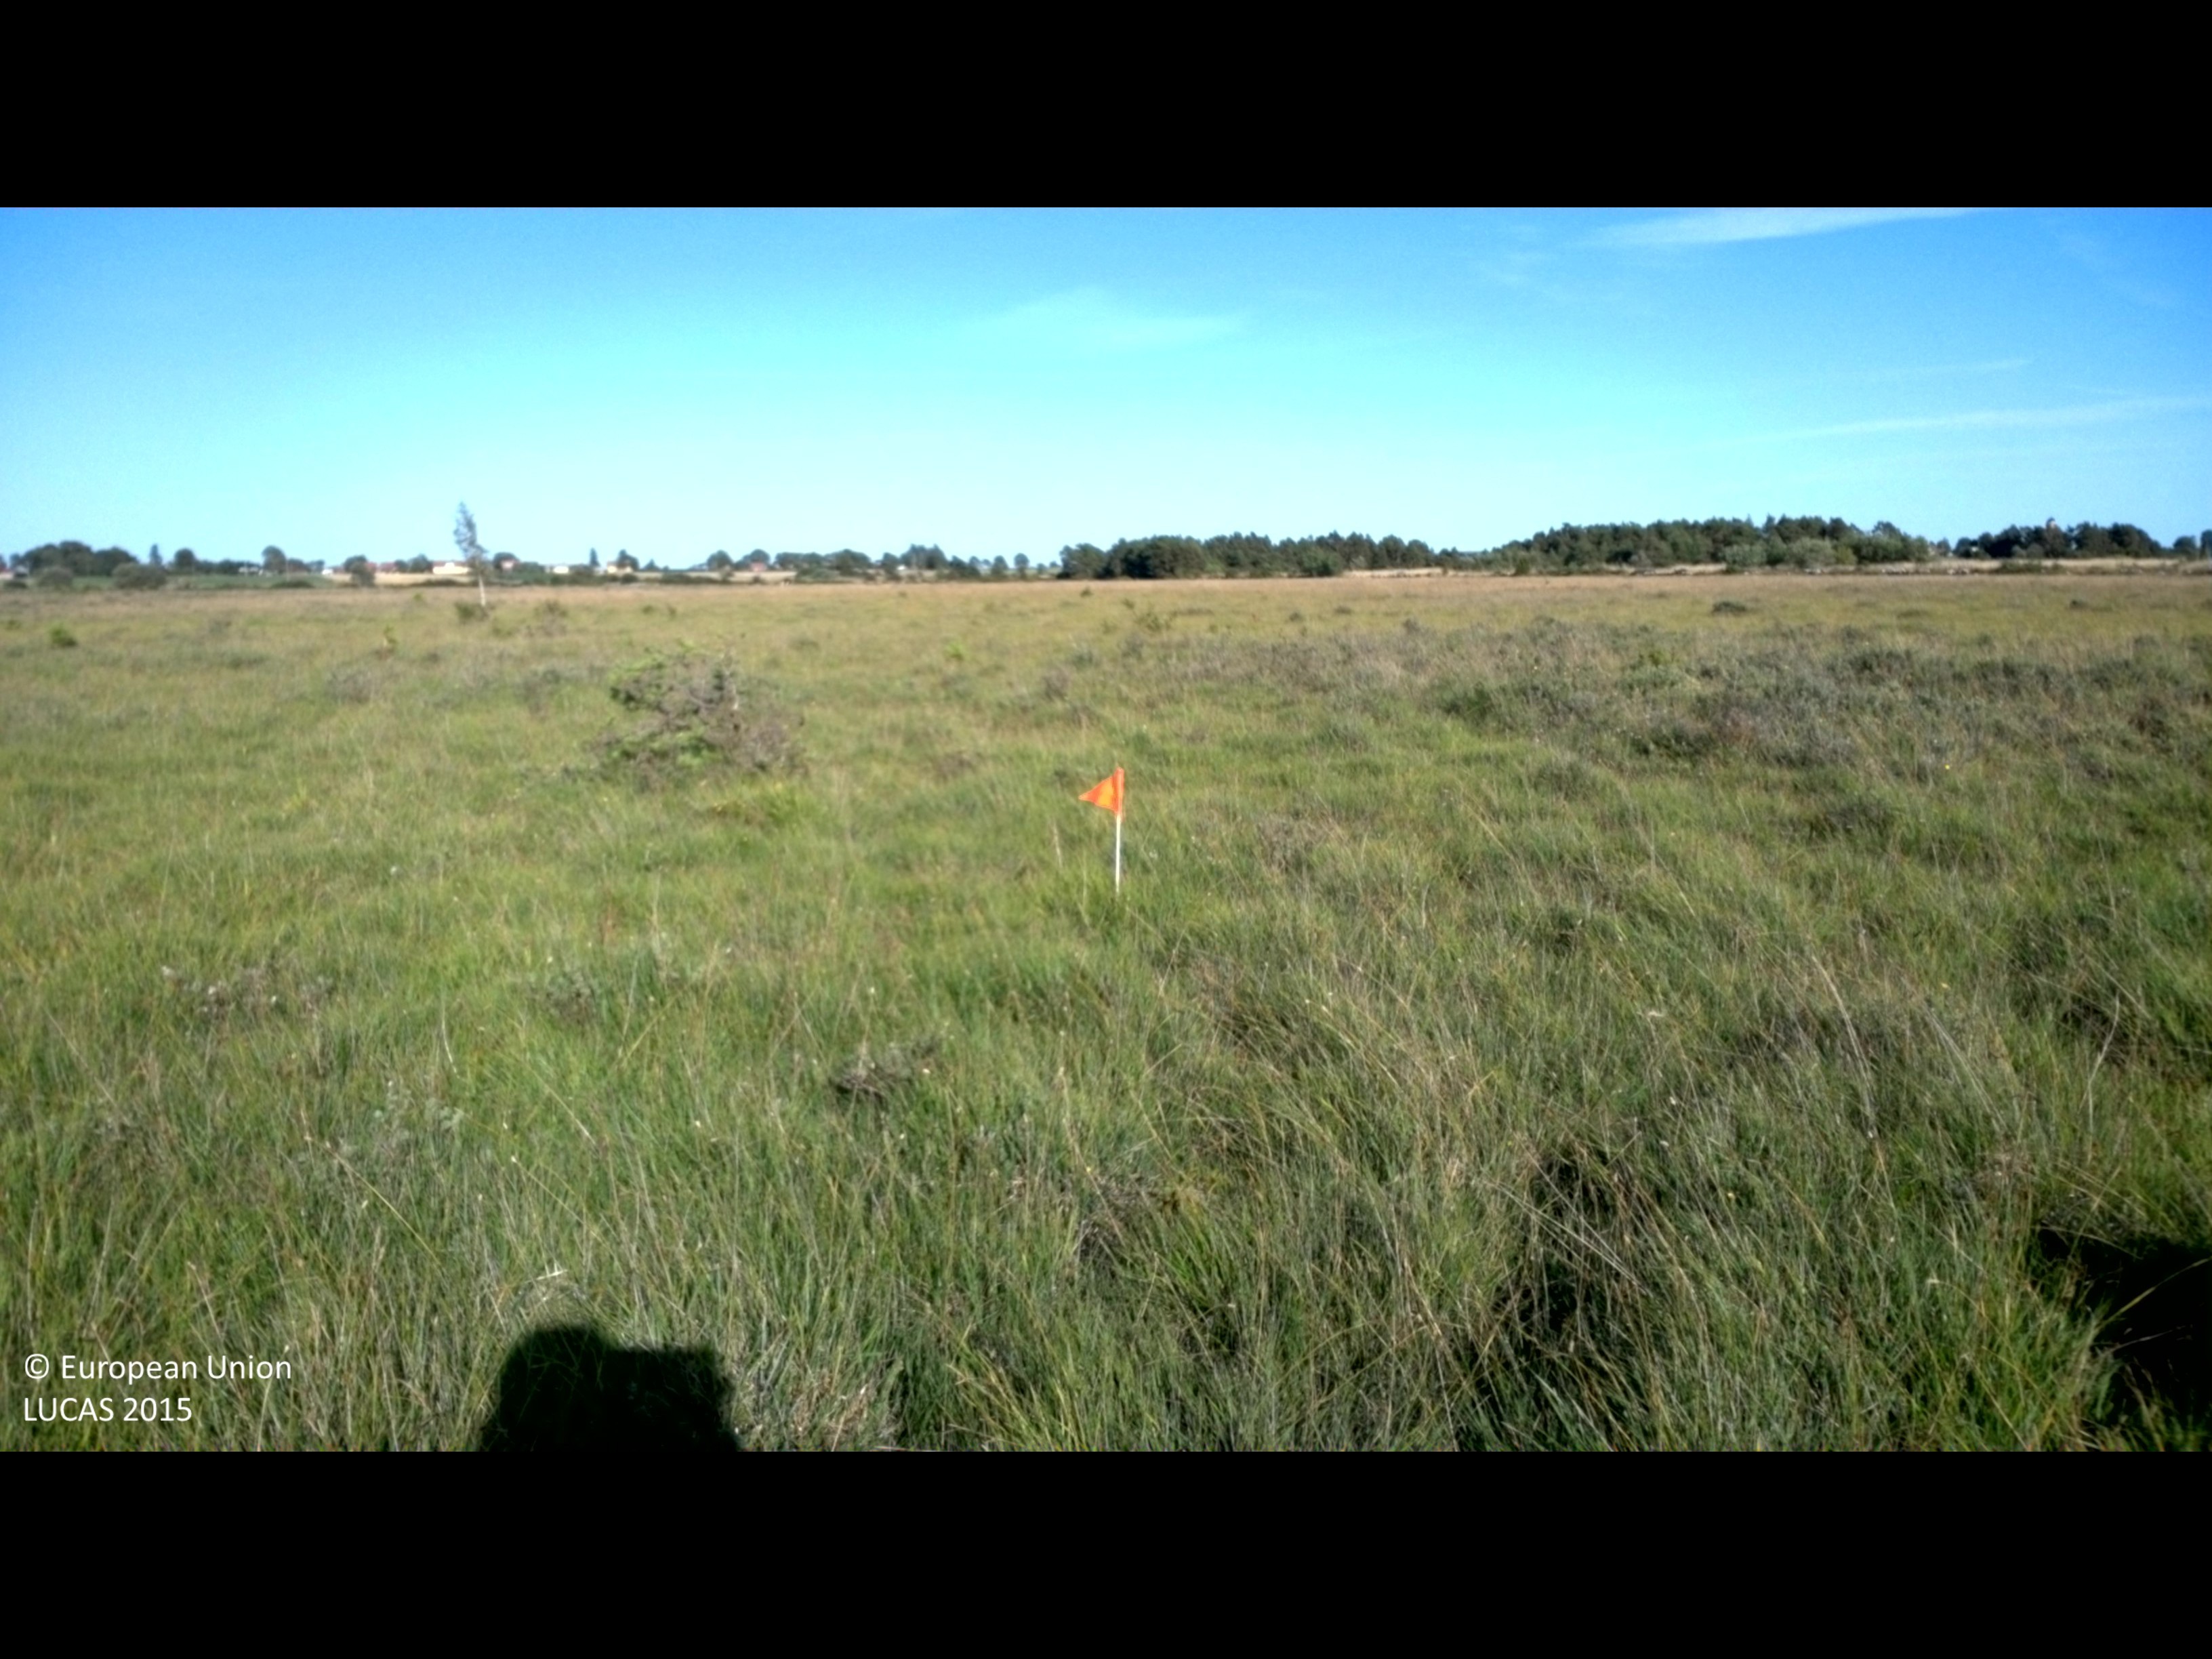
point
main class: Grassland
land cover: Grassland without tree/shrub cover
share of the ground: > 75 %
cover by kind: herbaceous plants 100 %
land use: Agriculture (excluding fallow land and kitchen gardens)
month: July
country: SE
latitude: 56.5239
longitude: 16.5855
